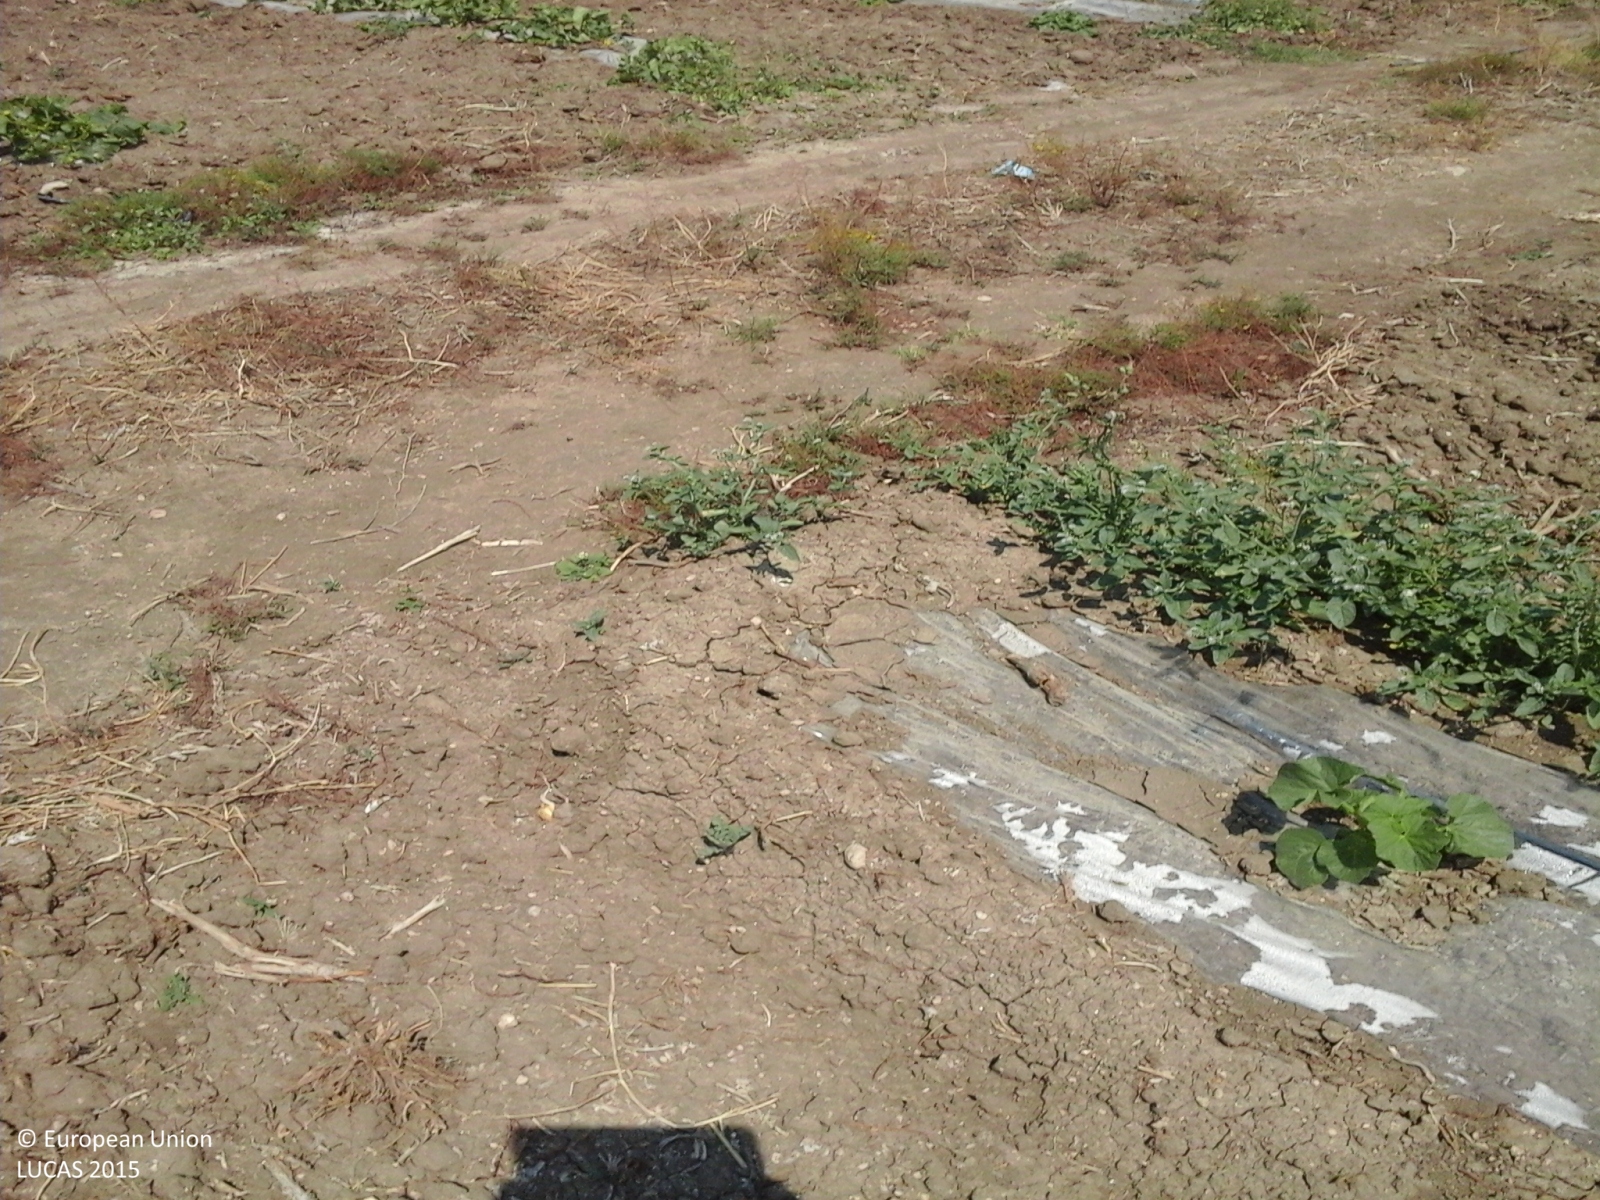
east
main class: Cropland
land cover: Other fresh vegetables
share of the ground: > 75 %
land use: Agriculture (excluding fallow land and kitchen gardens)
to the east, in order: Other fresh vegetables; Grass margins; Durum wheat; Tracks; Other fresh vegetables
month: July
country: IT
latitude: 37.1904
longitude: 14.4156
